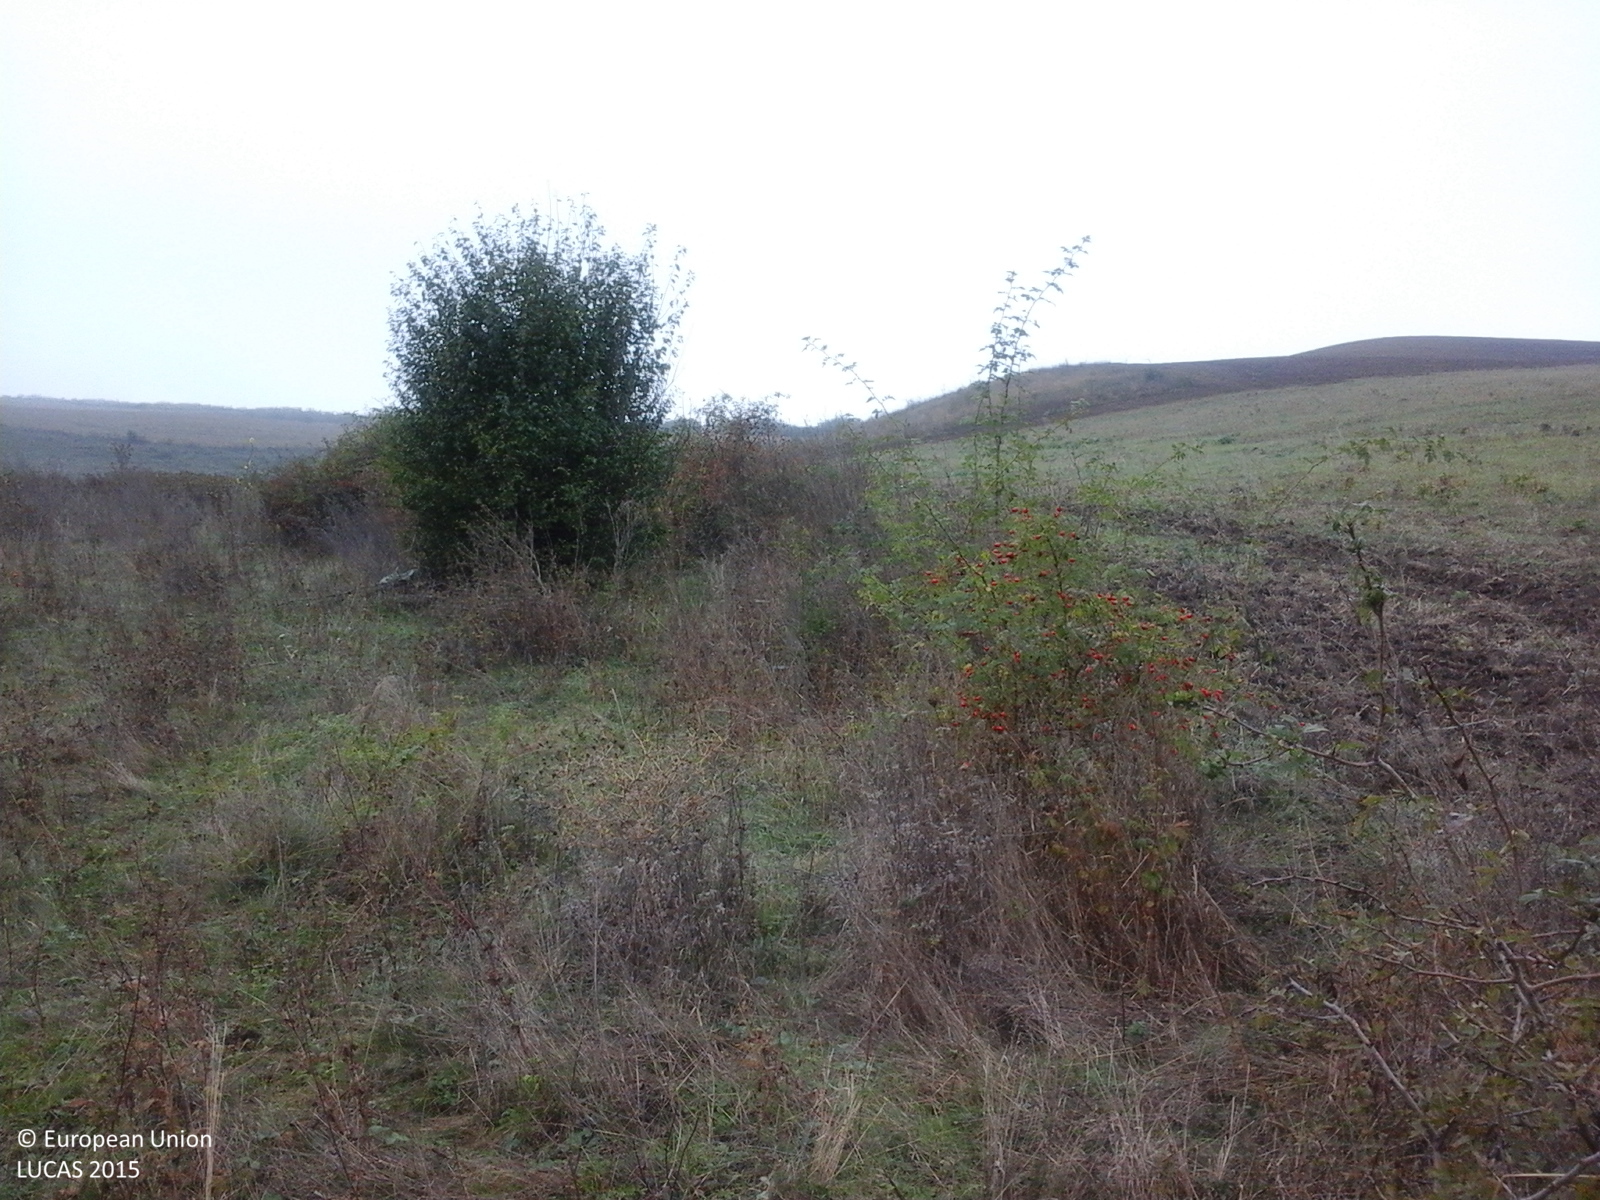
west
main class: Grassland
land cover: Grassland with sparse tree/shrub cover
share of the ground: > 75 %
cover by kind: herbaceous plants 95 %, broadleaved forest trees 5 %
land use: Agriculture (excluding fallow land and kitchen gardens)
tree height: < 5 m
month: October
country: RO
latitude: 46.5941
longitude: 24.1380
